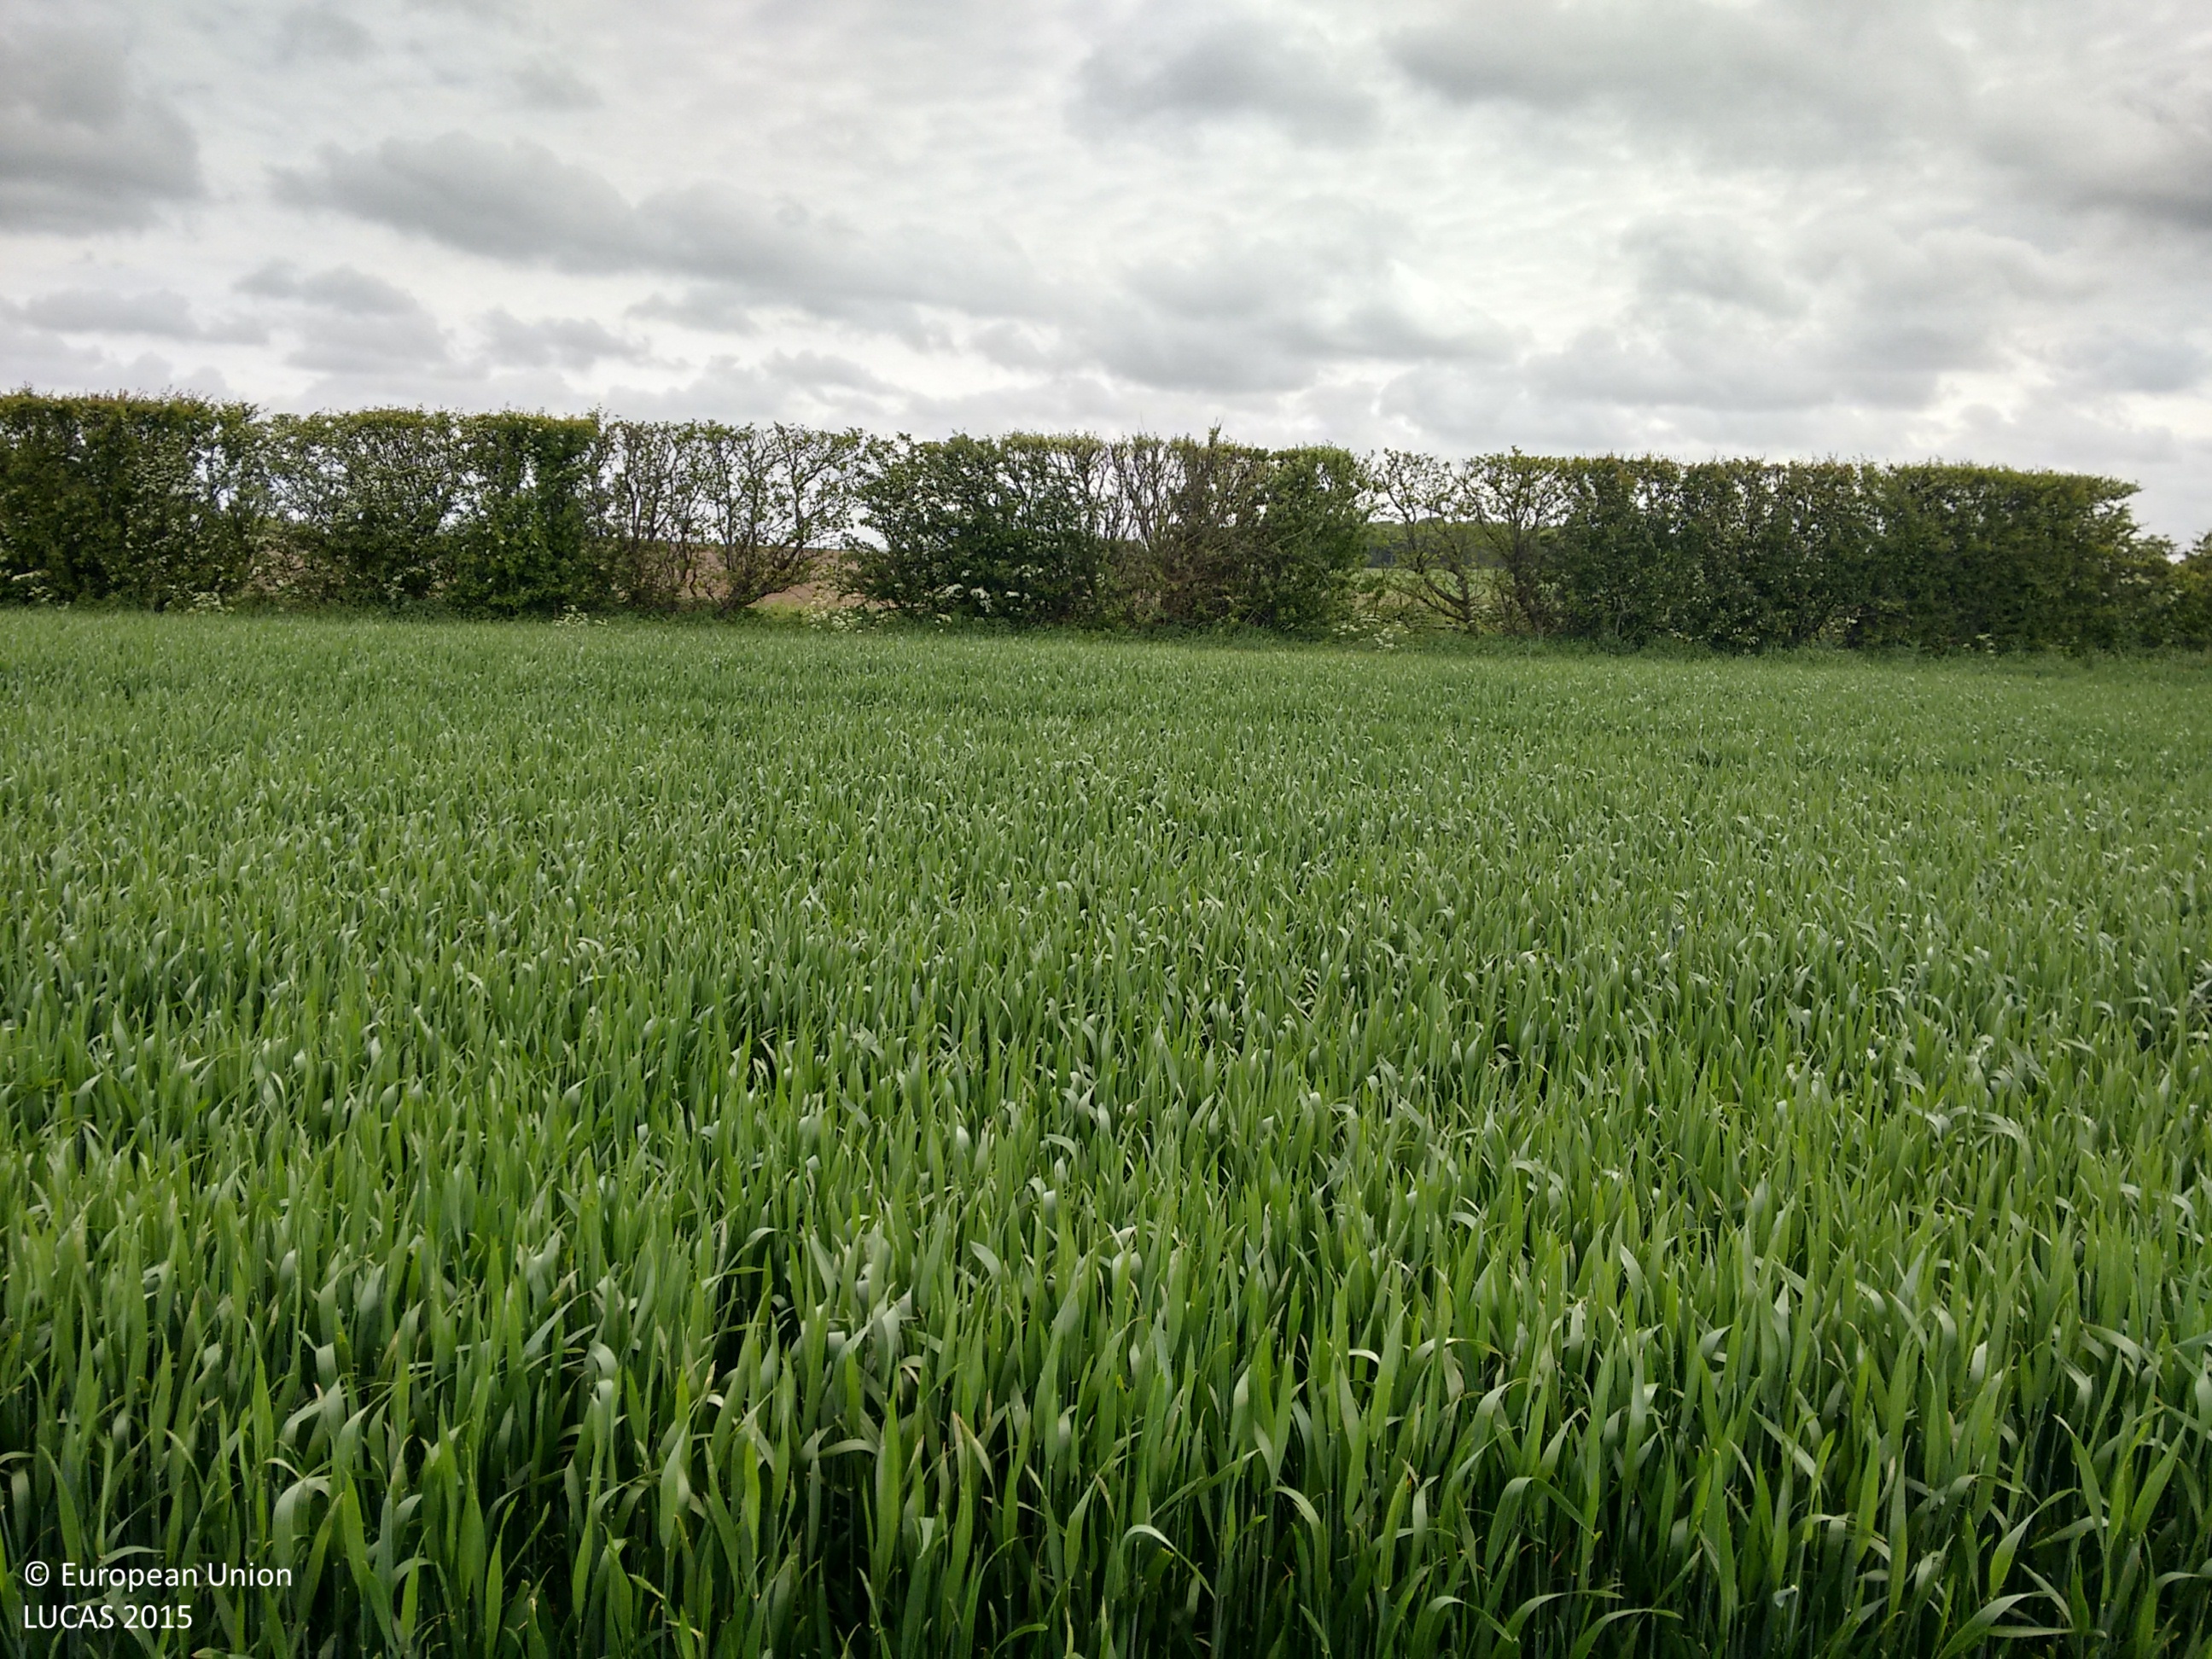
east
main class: Cropland
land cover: Common wheat
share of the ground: > 75 %
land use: Agriculture (excluding fallow land and kitchen gardens)
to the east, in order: Common wheat; Grassland without tree/shrub cover; Managed hedges; Grass margins; Paved roads, cycling and walking lanes; Grass margins; Tracks; Barley
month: May
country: GB
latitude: 53.5383
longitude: -2.9748
